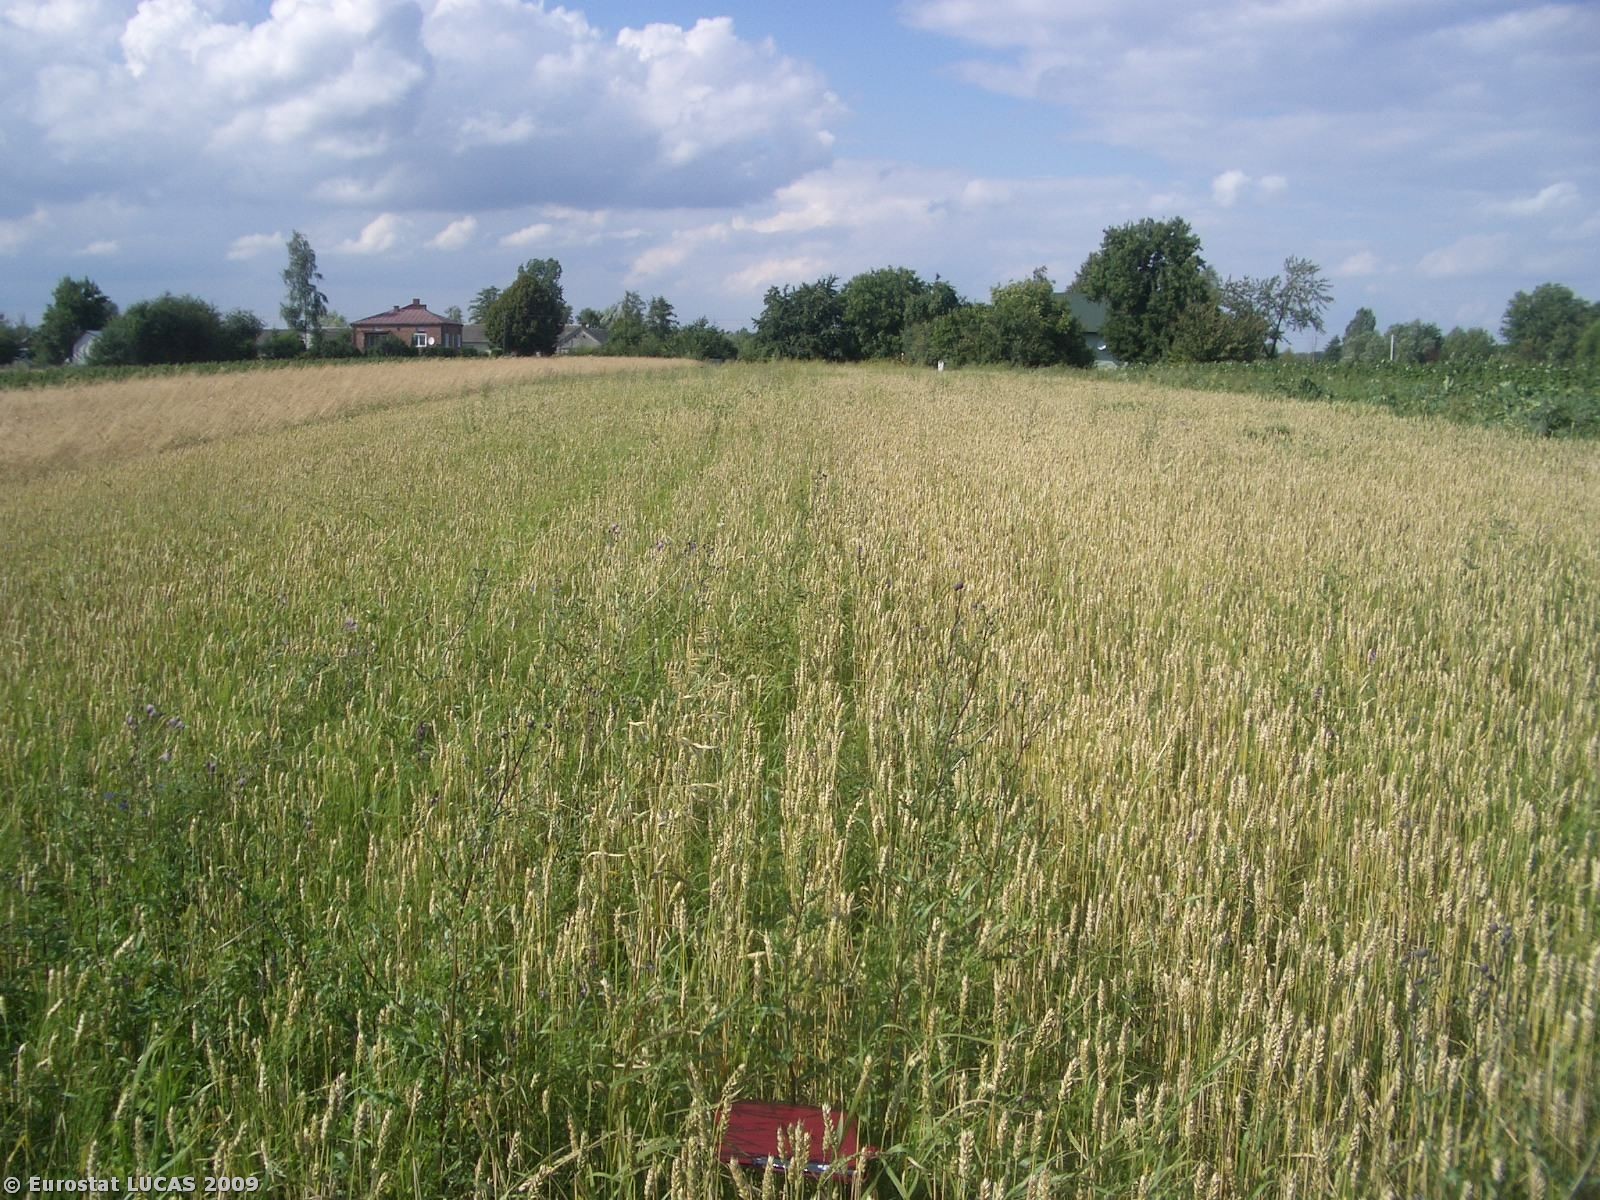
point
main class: Cropland
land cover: Common wheat
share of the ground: 50 - 75 %
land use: Agriculture (excluding fallow land and kitchen gardens)
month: July
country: PL
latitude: 51.6252
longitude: 22.4745
